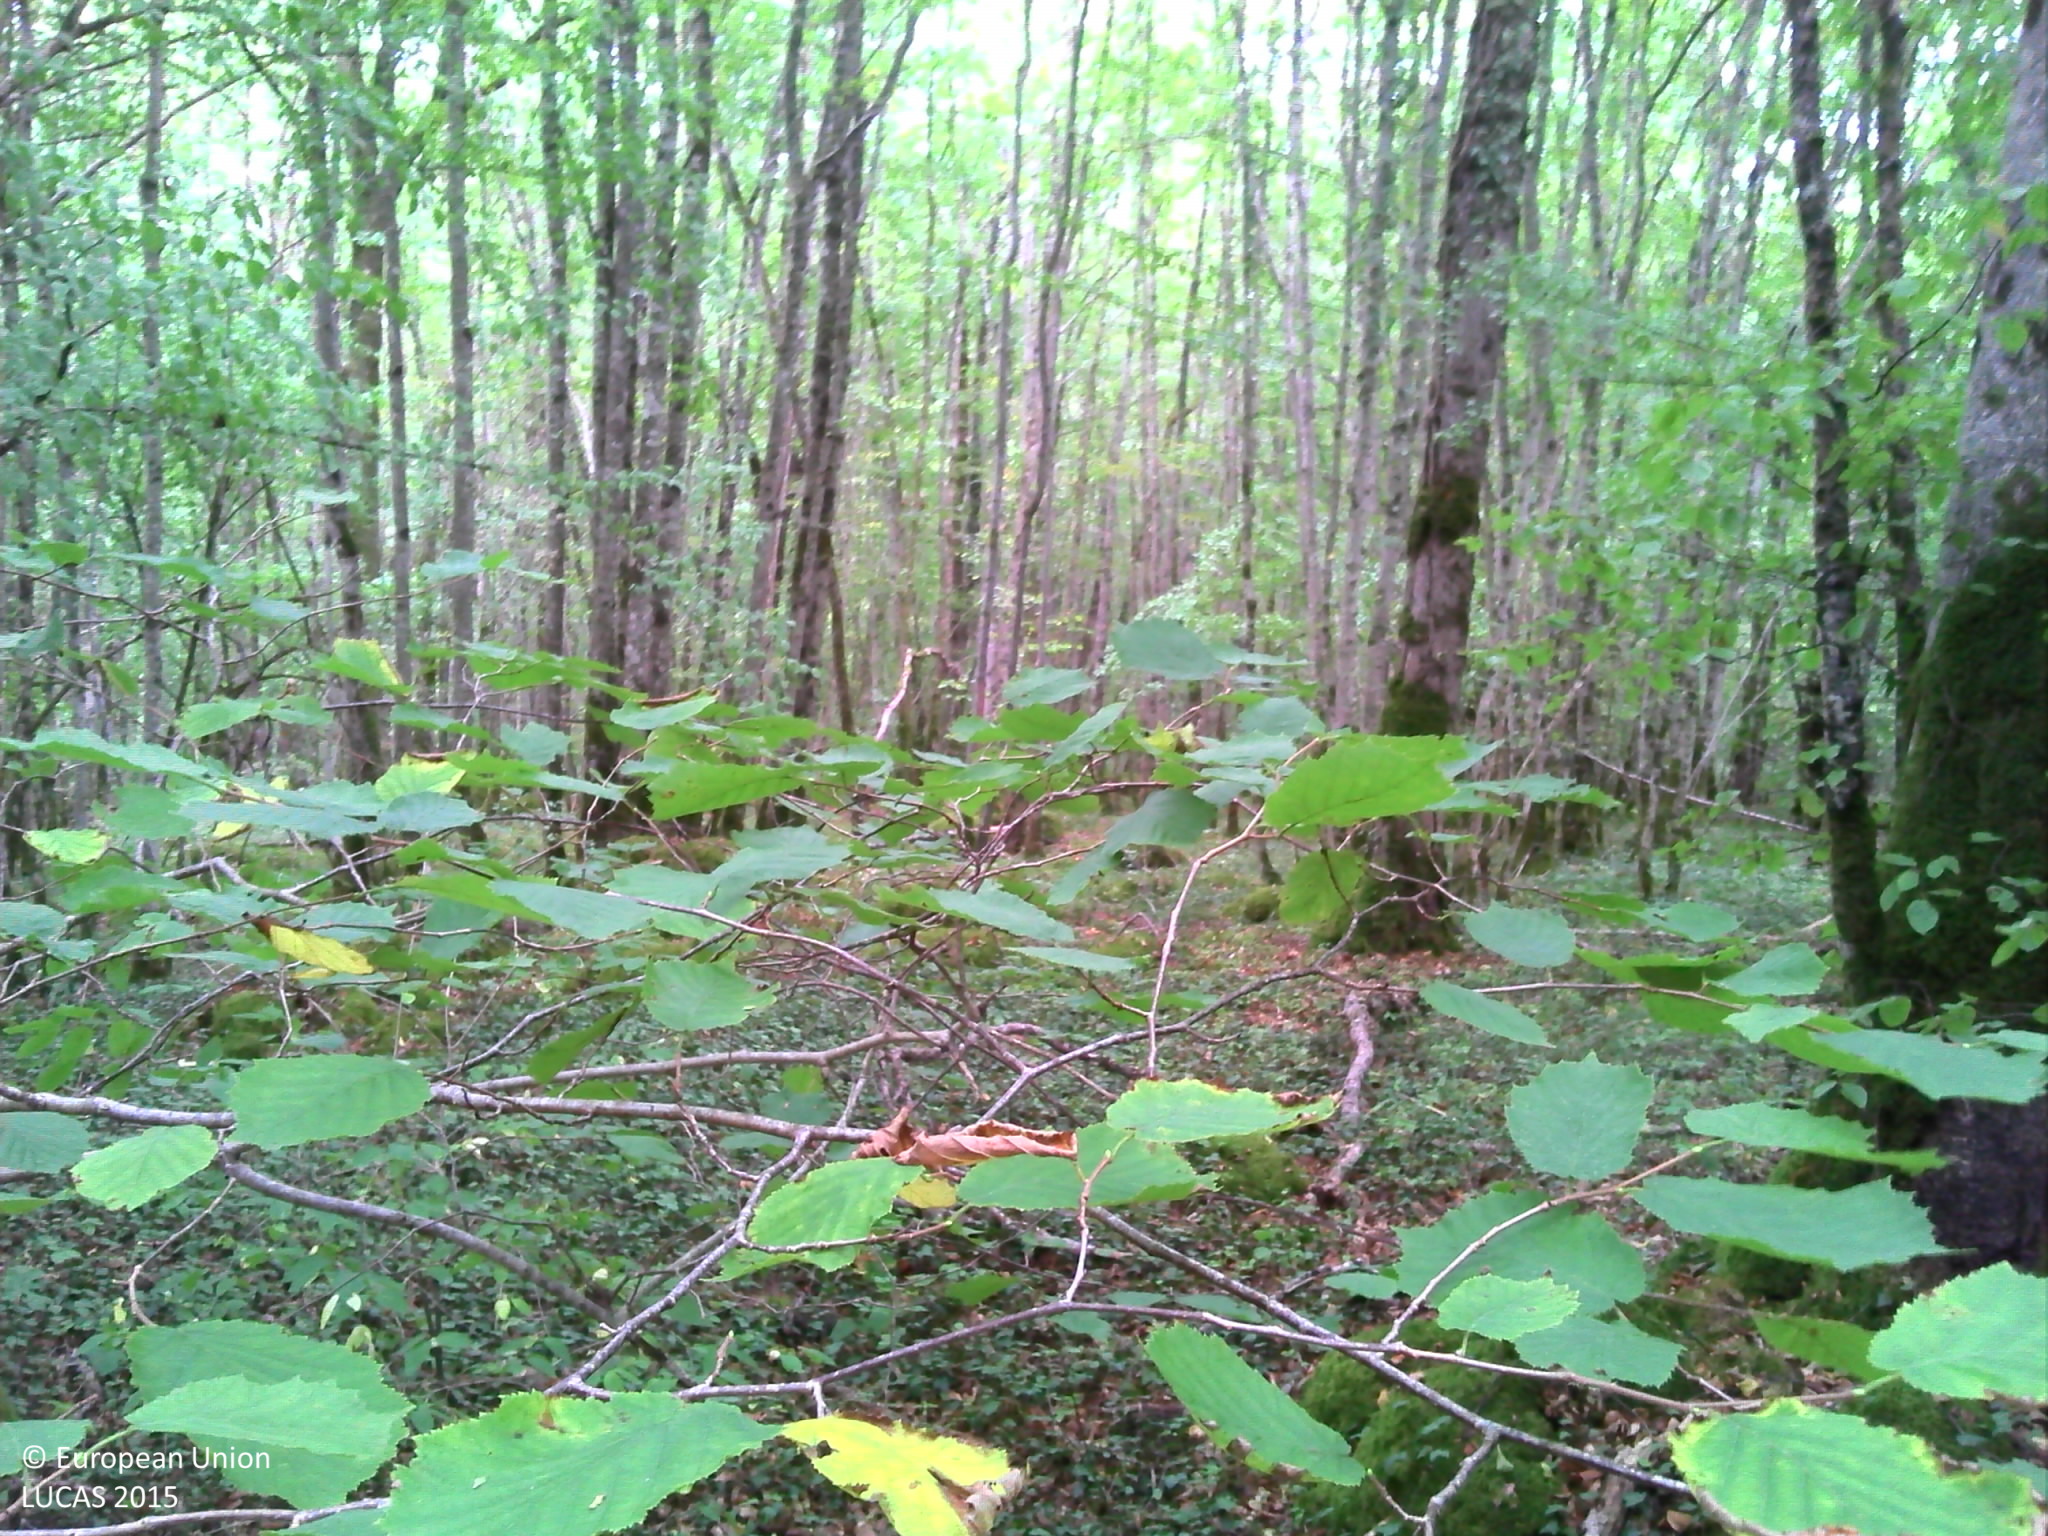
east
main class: Woodland
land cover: Broadleaved woodland
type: beech forest
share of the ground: > 75 %
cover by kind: broadleaved forest trees 90 %, herbaceous plants 5 %, lichens and mosses 5 %
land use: Forestry
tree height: > 5 m
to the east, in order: Broadleaved woodland
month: August
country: FR
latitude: 47.7625
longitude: 4.8895
